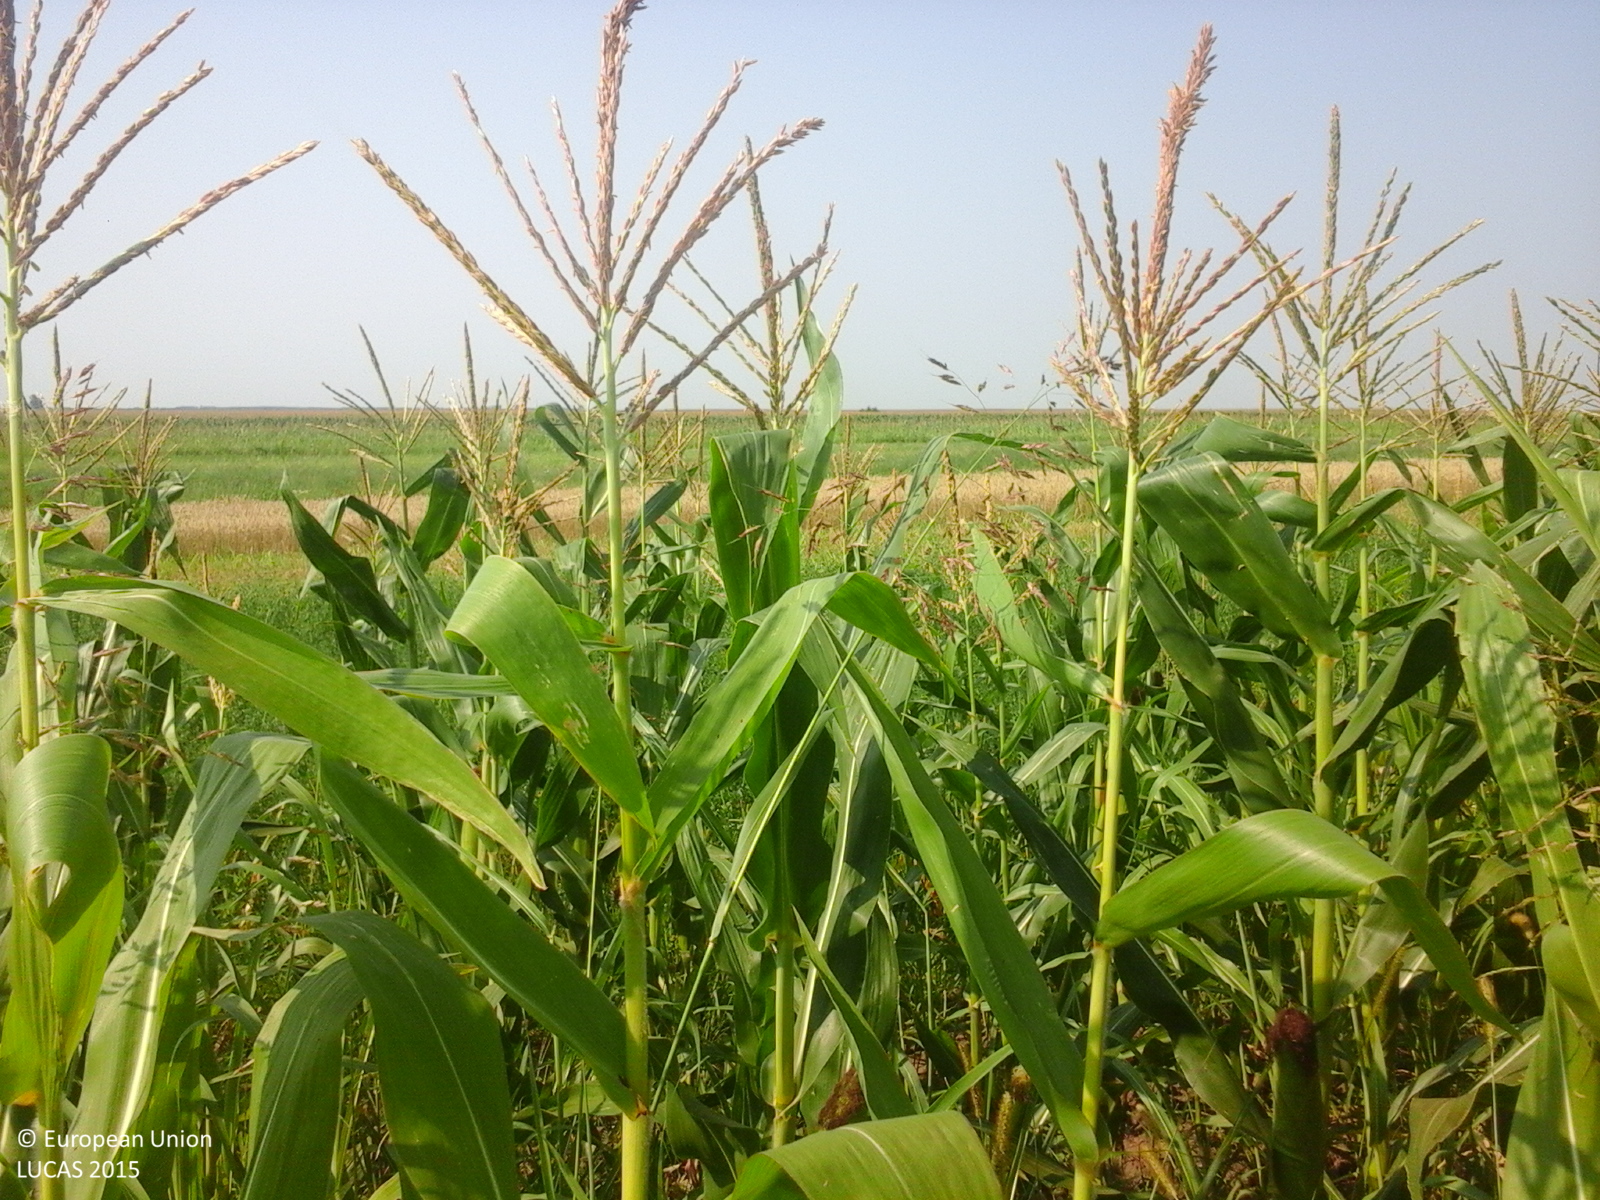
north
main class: Cropland
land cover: Maize
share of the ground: > 75 %
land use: Agriculture (excluding fallow land and kitchen gardens)
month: July
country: RO
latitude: 44.8868
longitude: 26.8801
